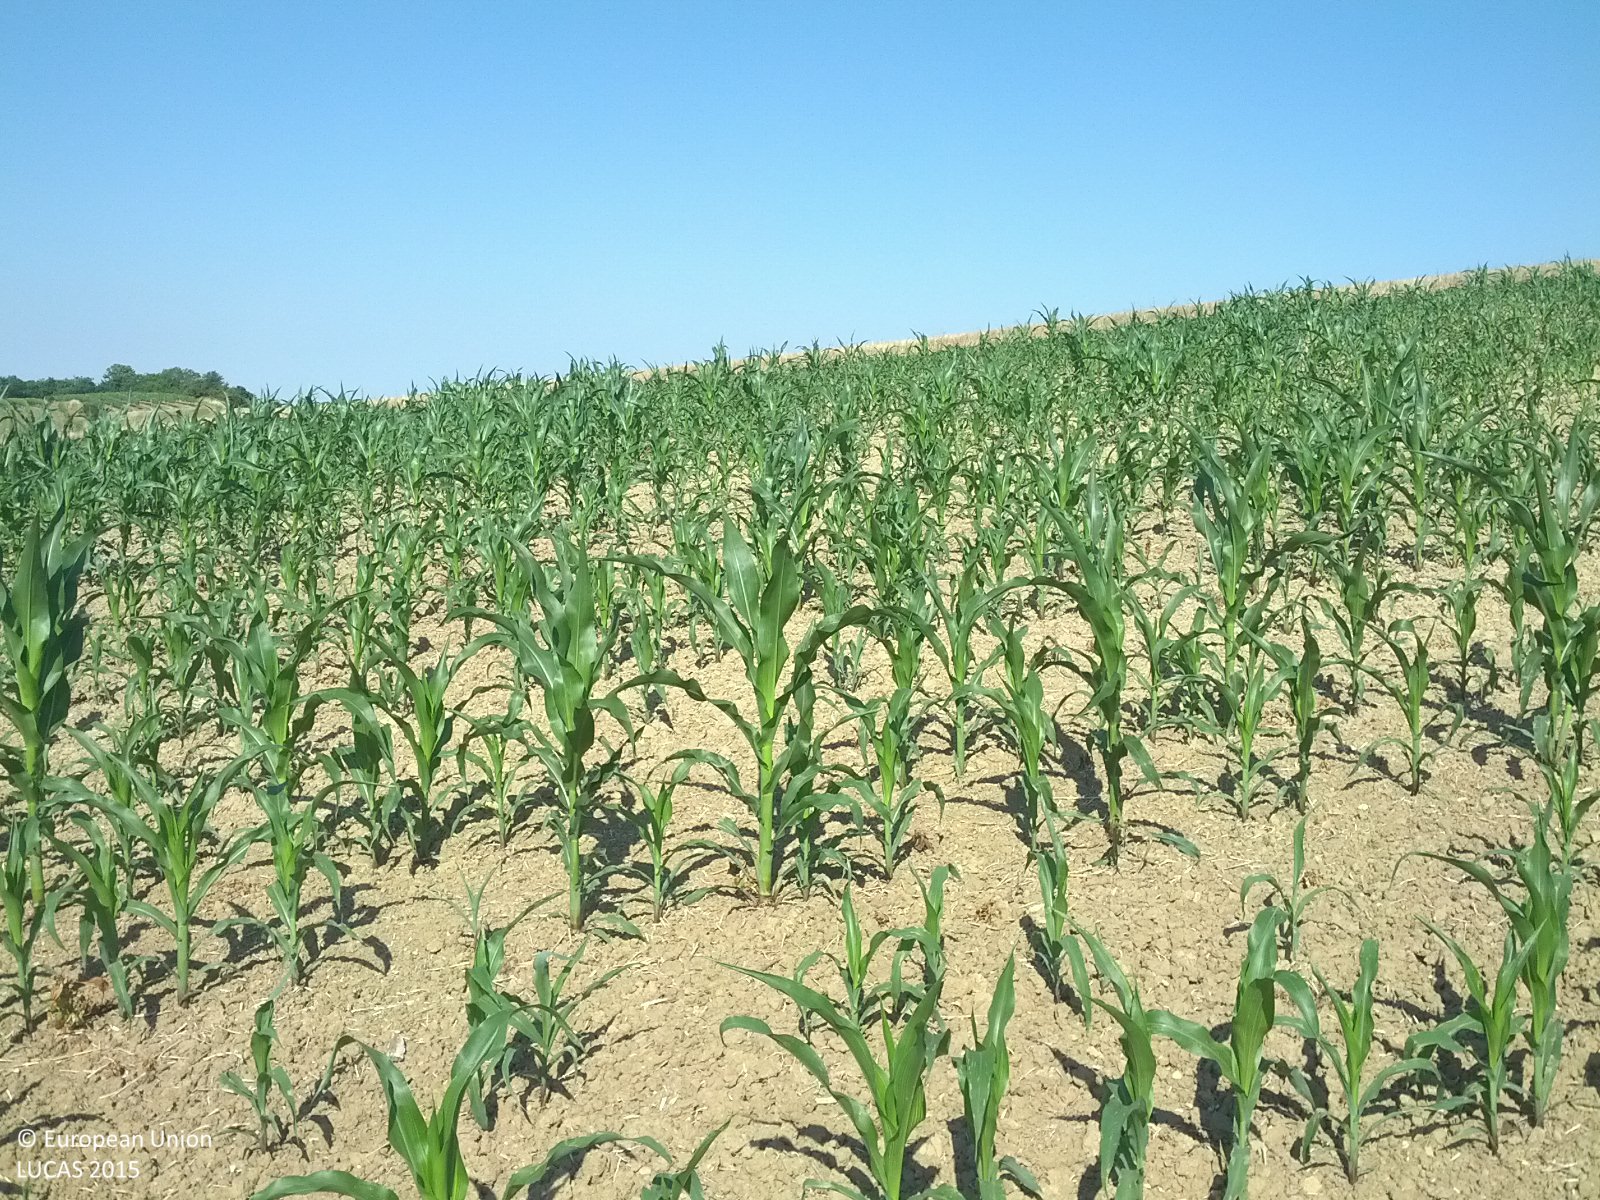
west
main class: Cropland
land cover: Maize
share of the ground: 10 - 25 %
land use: Agriculture (excluding fallow land and kitchen gardens)
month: July
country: AT
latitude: 48.6776
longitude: 16.5663
